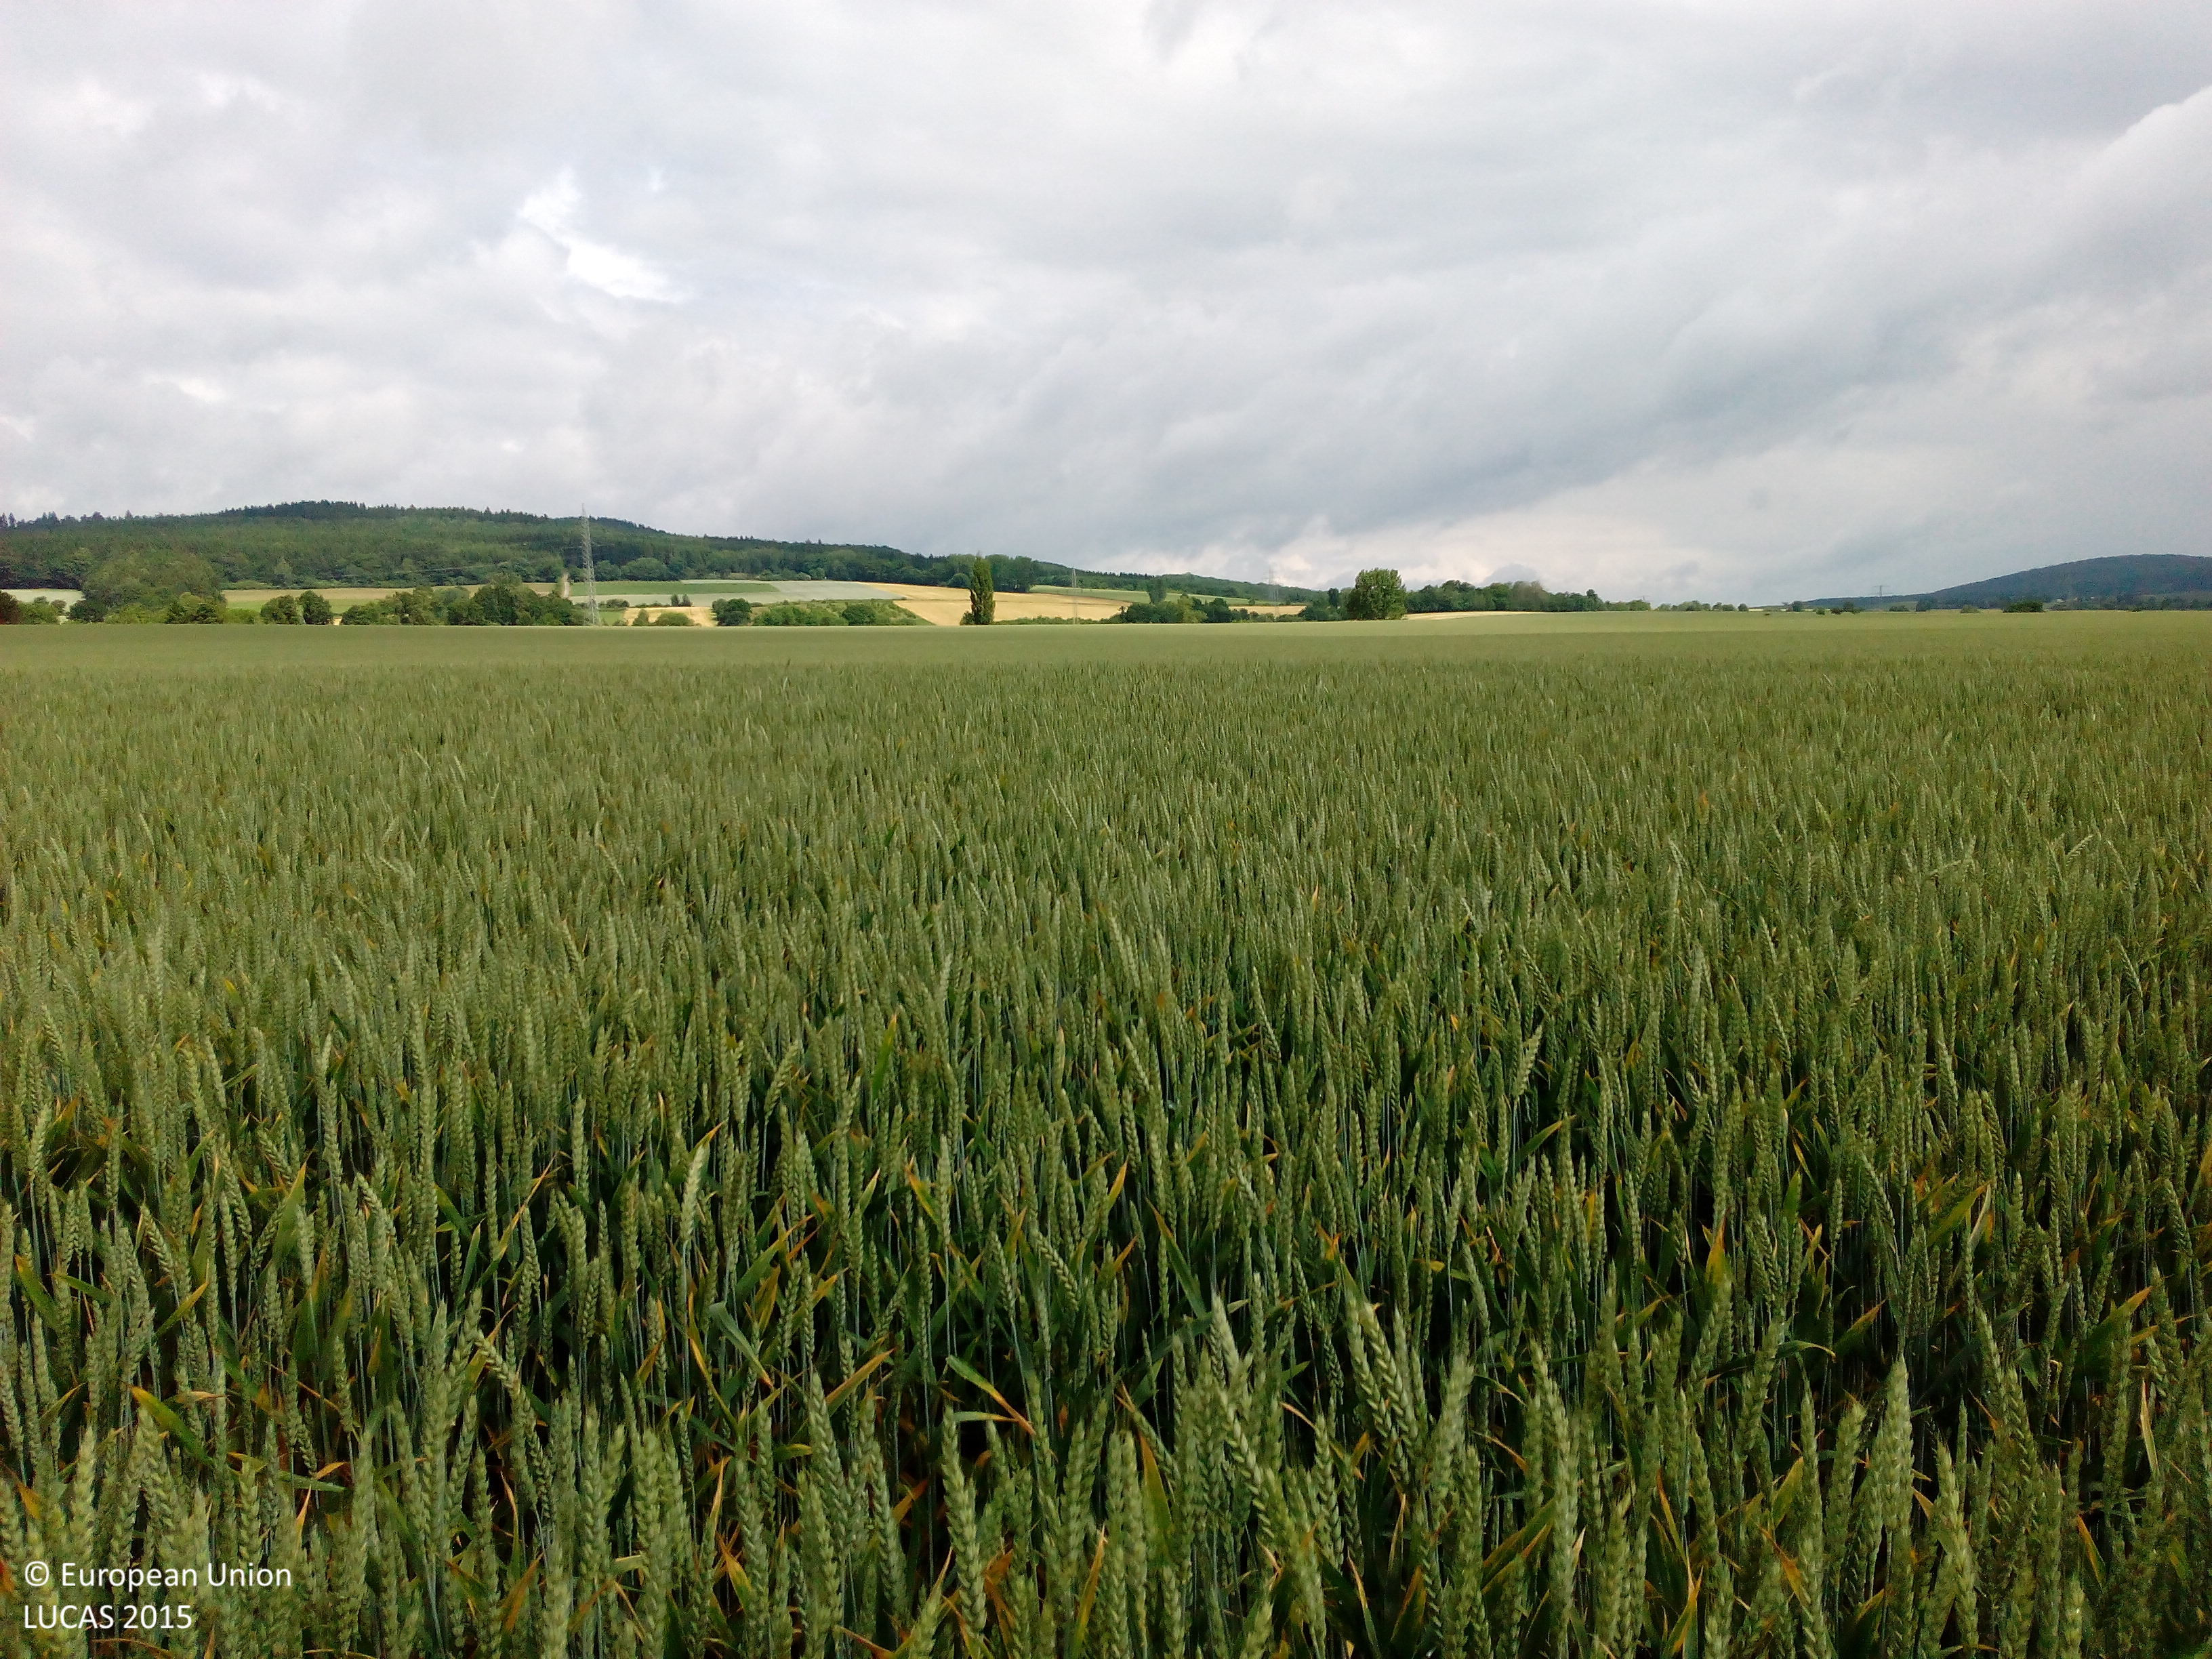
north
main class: Cropland
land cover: Common wheat
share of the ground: > 75 %
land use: Agriculture (excluding fallow land and kitchen gardens)
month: June
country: DE
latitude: 51.8741
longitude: 9.8403
